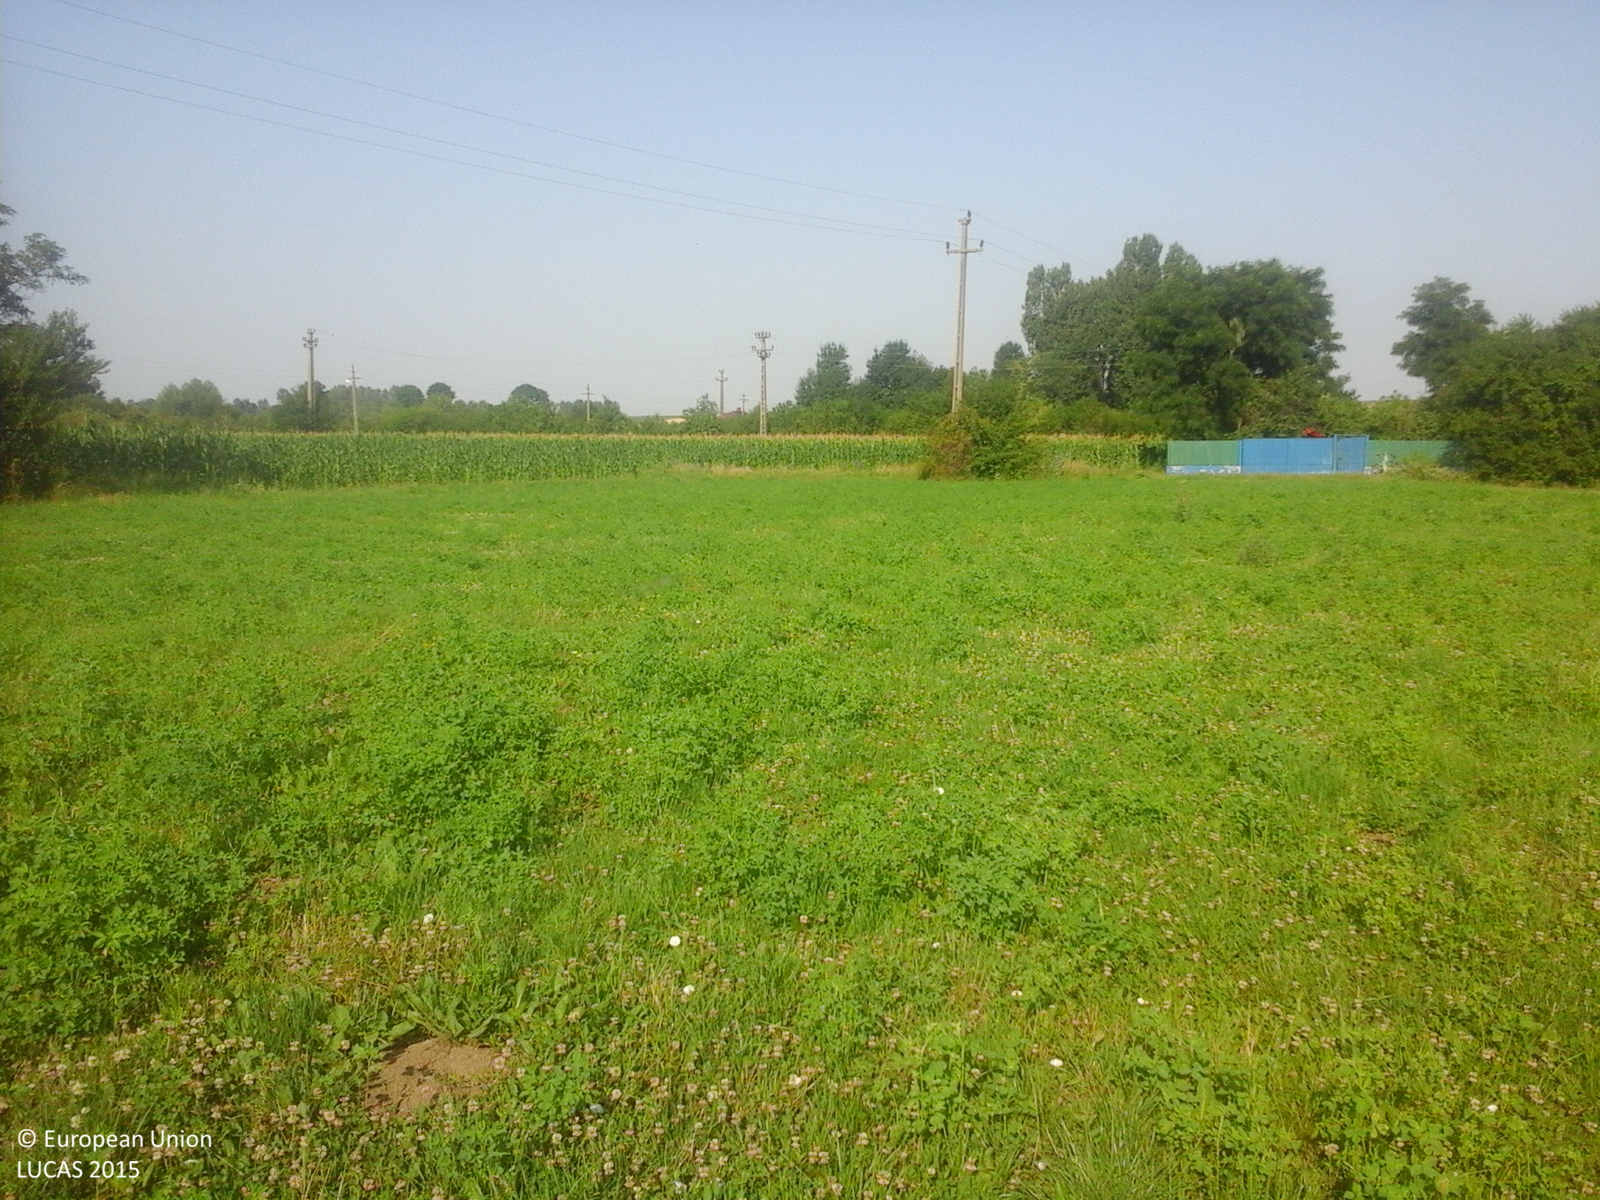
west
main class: Cropland
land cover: Other leguminous and mixtures for fodder
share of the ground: > 75 %
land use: Agriculture (excluding fallow land and kitchen gardens)
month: July
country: RO
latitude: 44.5118
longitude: 24.7822
